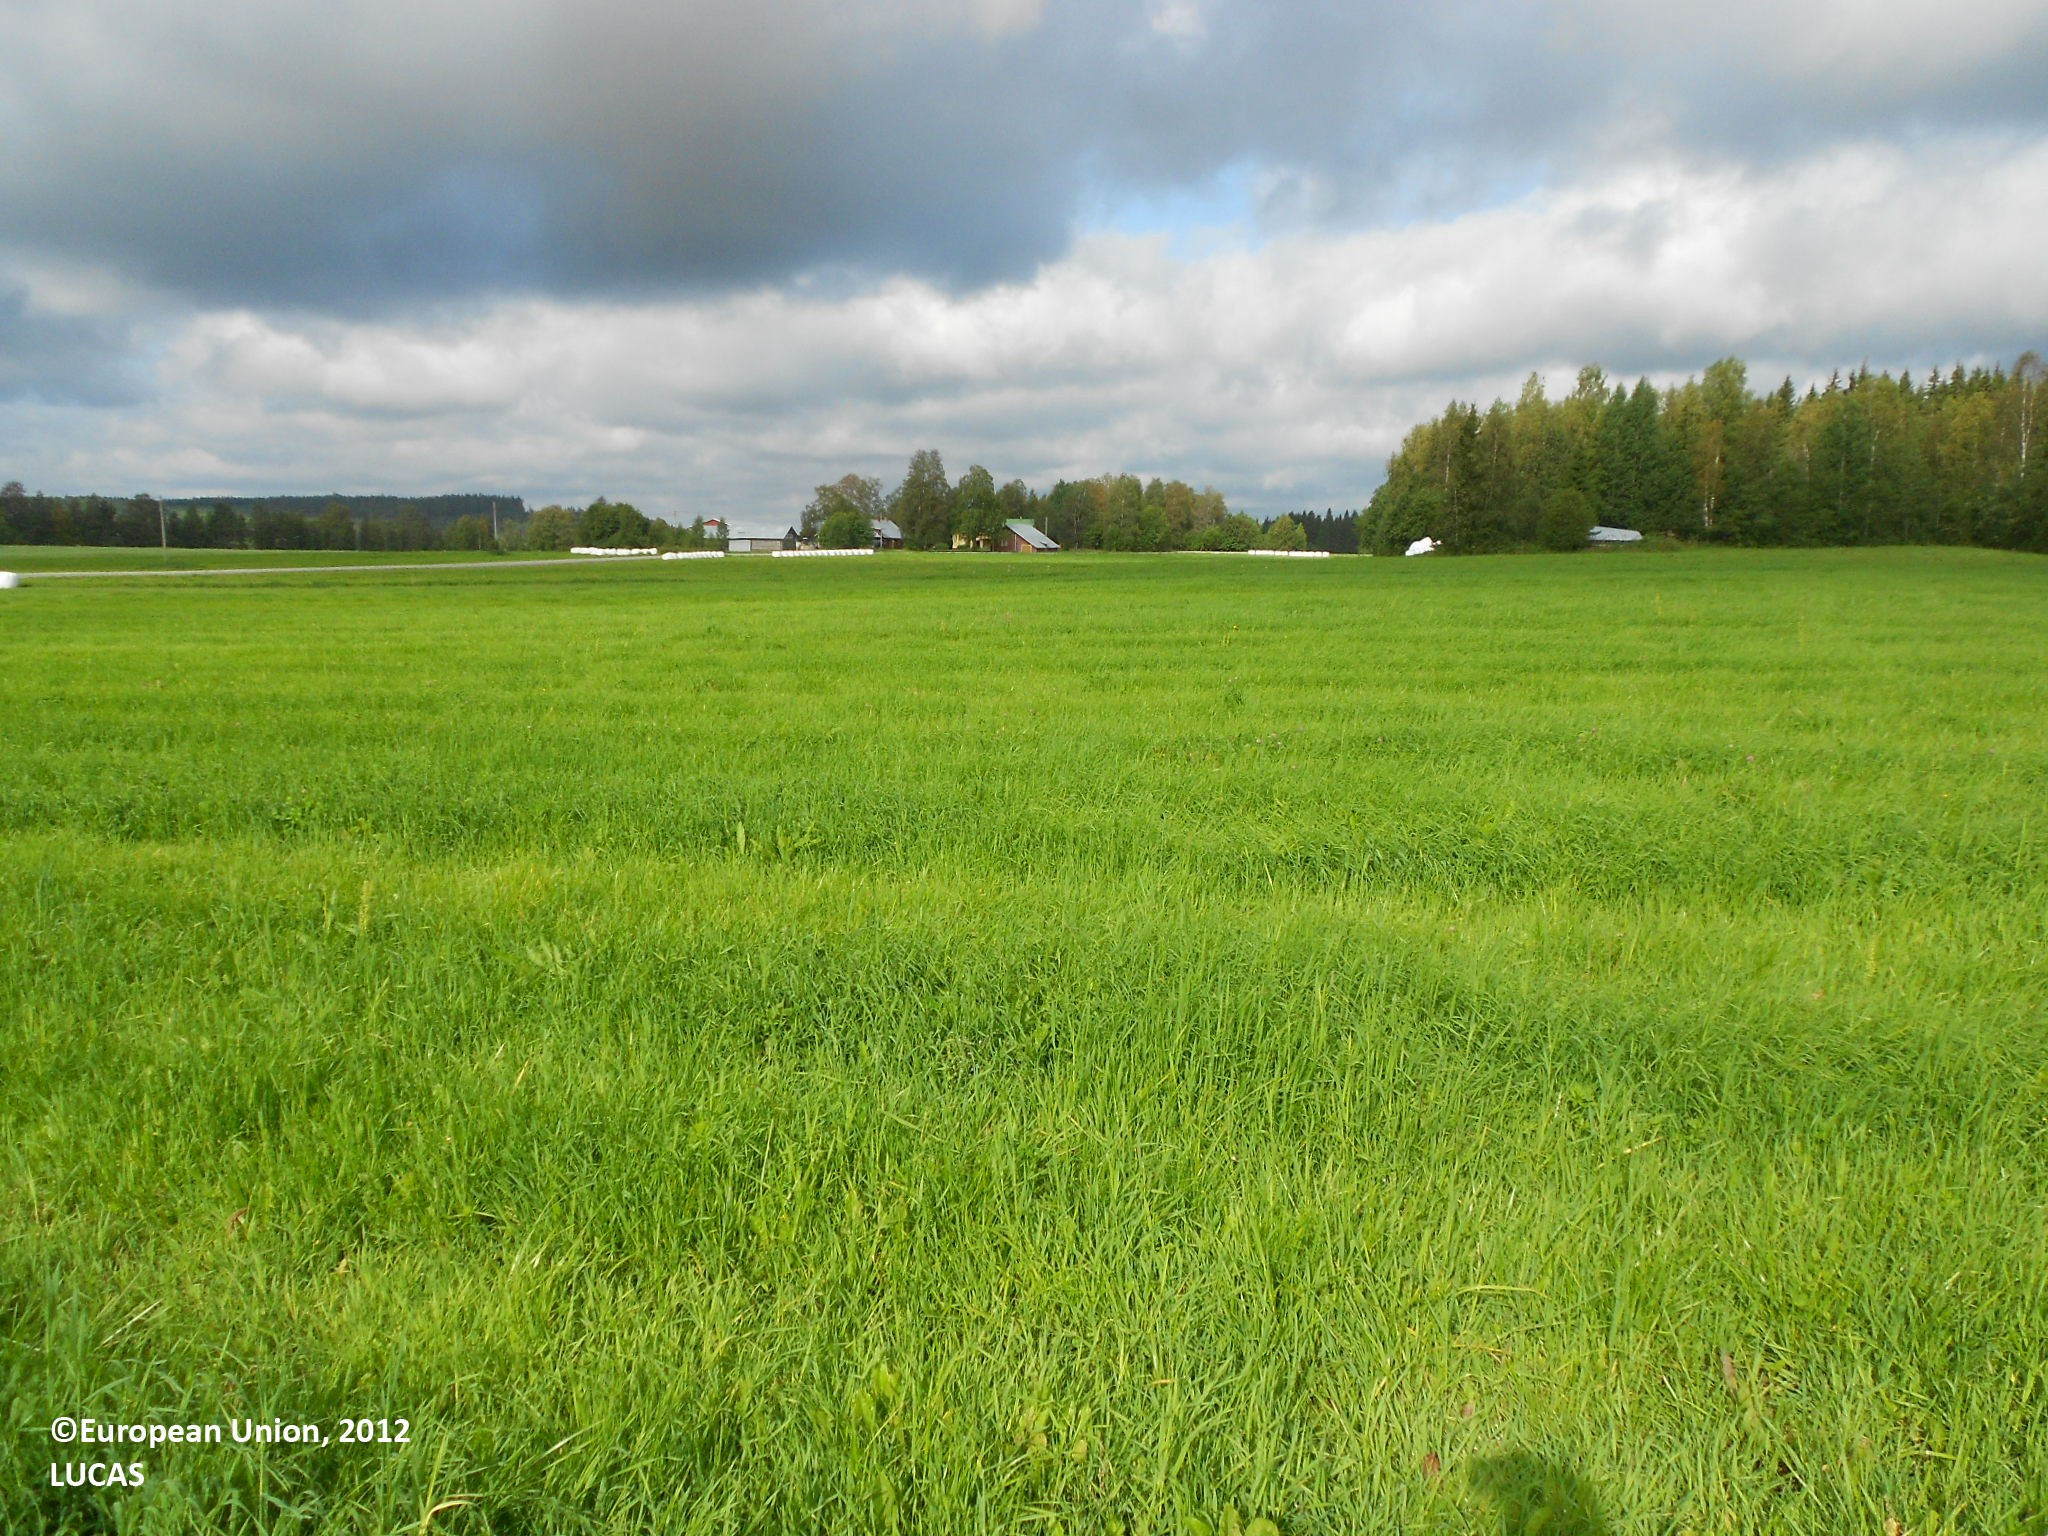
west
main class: Cropland
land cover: Temporary grasslands
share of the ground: > 75 %
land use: Agriculture (excluding fallow land and kitchen gardens)
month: August
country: FI
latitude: 63.7035
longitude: 28.6642
